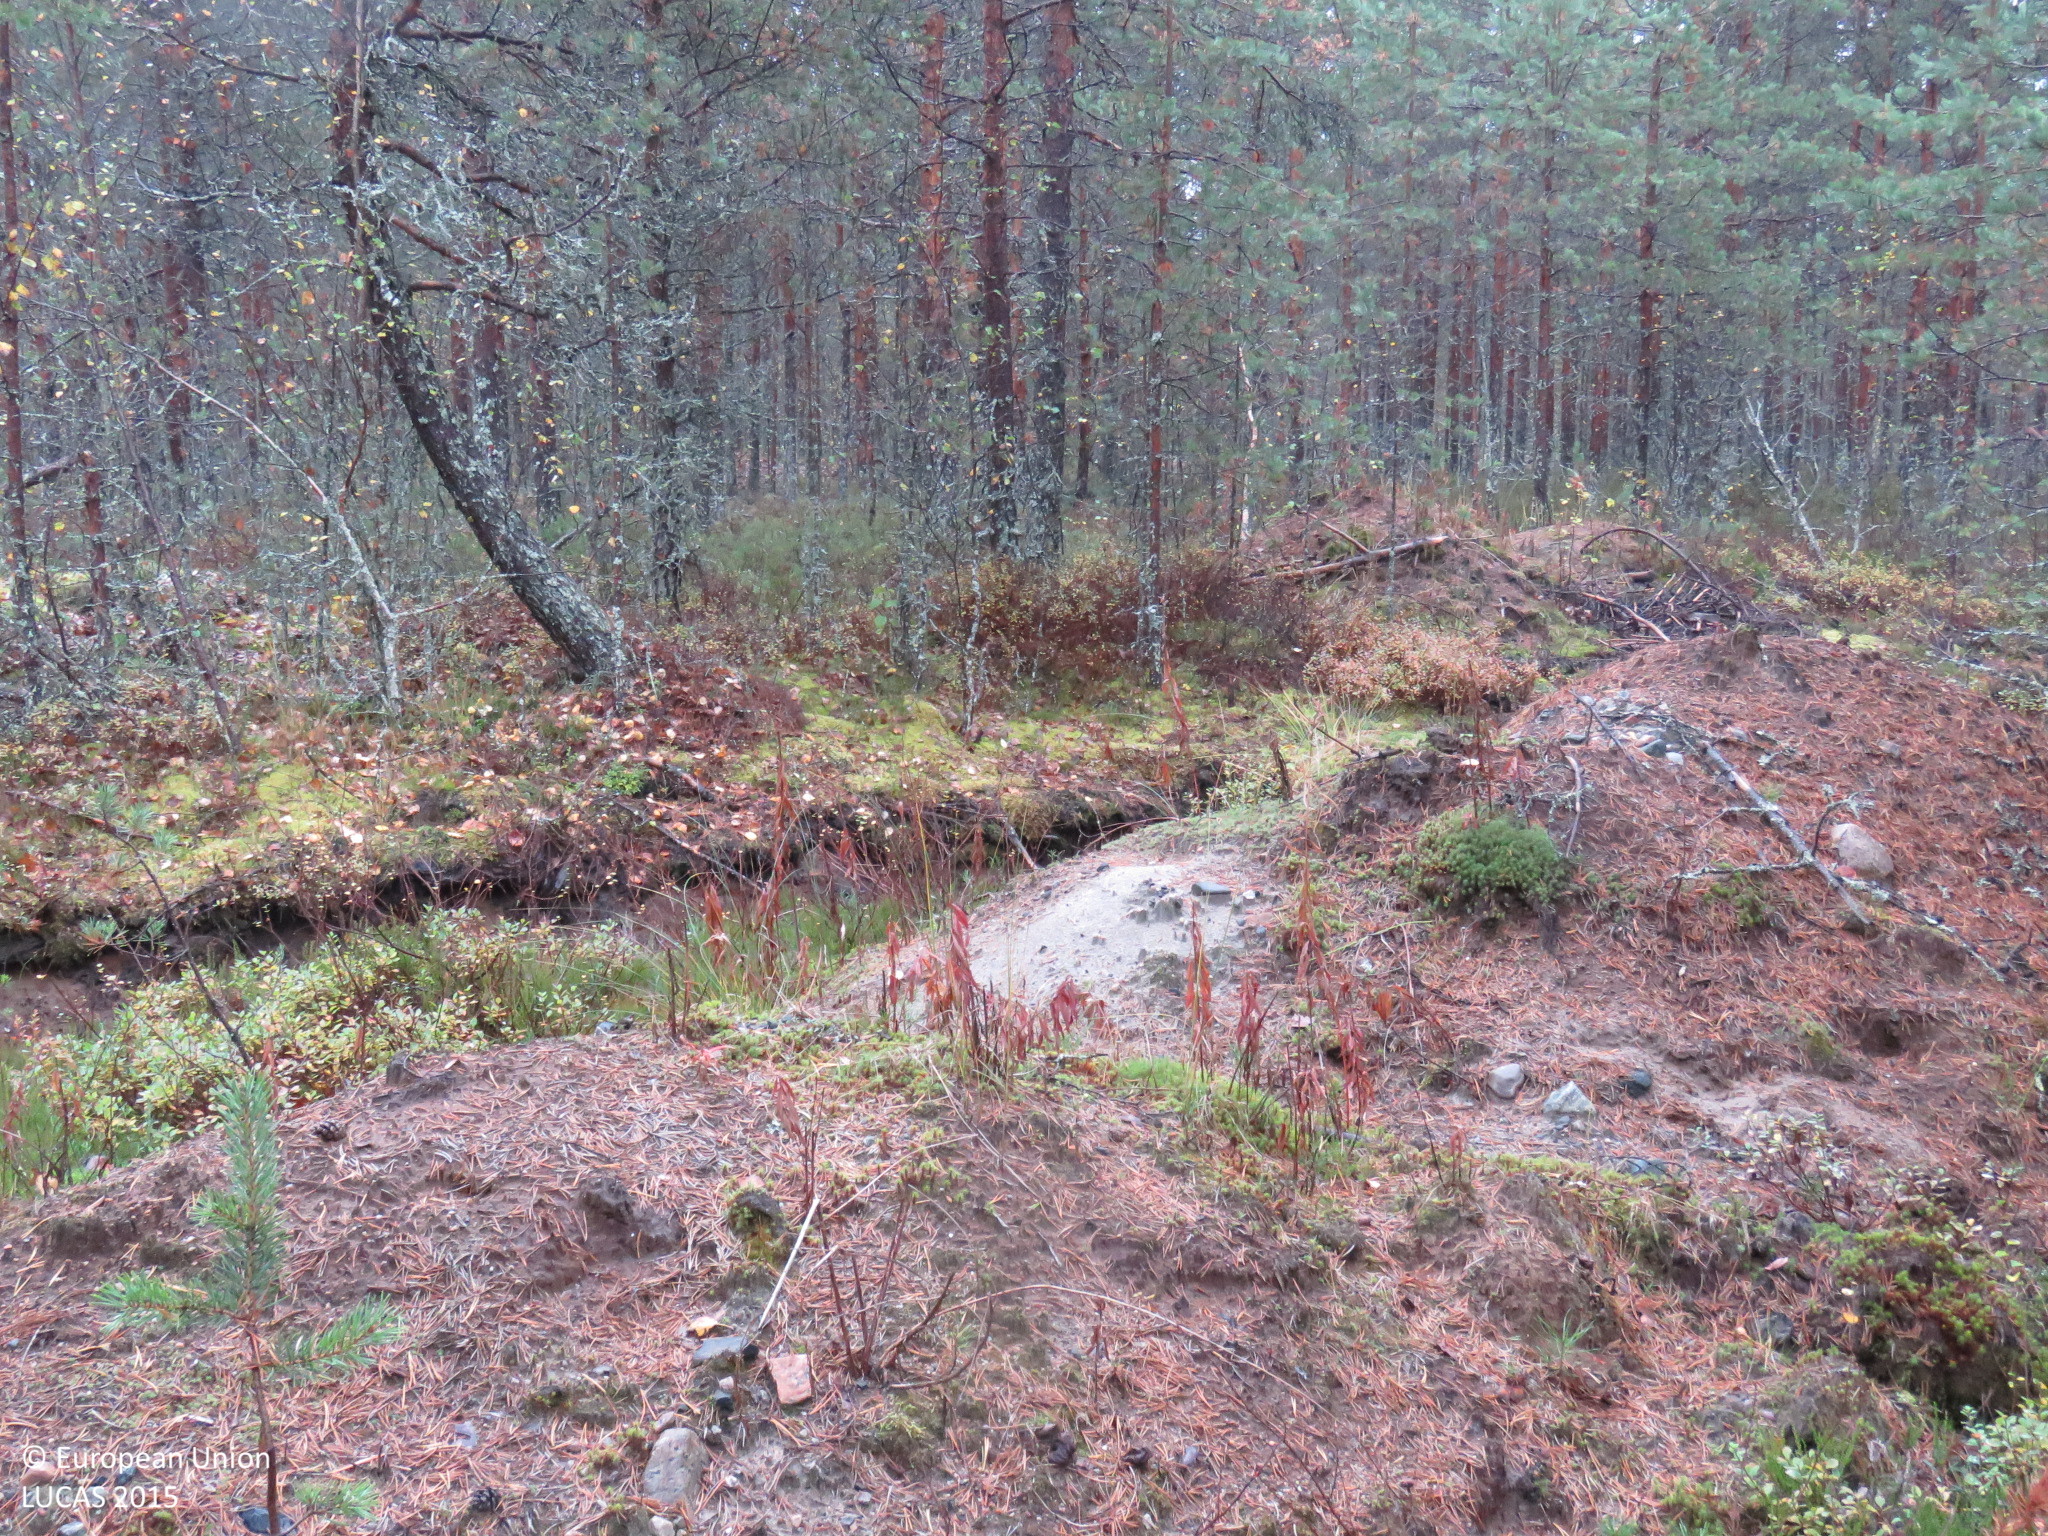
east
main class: Woodland
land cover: Pine dominated coniferous woodland
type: boreal forest
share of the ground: > 75 %
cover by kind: coniferous forest trees 70 %, shrubs 20 %, broadleaved forest trees 5 %, lichens and mosses 5 %
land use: Forestry
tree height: > 5 m
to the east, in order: Pine dominated coniferous woodland; Ditches and canals; Pine dominated coniferous woodland; Ditches and canals; Pine dominated coniferous woodland; Ditches and canals; Pine dominated coniferous woodland; Ditches and canals; Pine dominated coniferous woodland; Ditches and canals; Pine dominated coniferous woodland; Ditches and canals; Pine dominated coniferous woodland
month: September
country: FI
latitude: 65.1352
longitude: 26.5407
